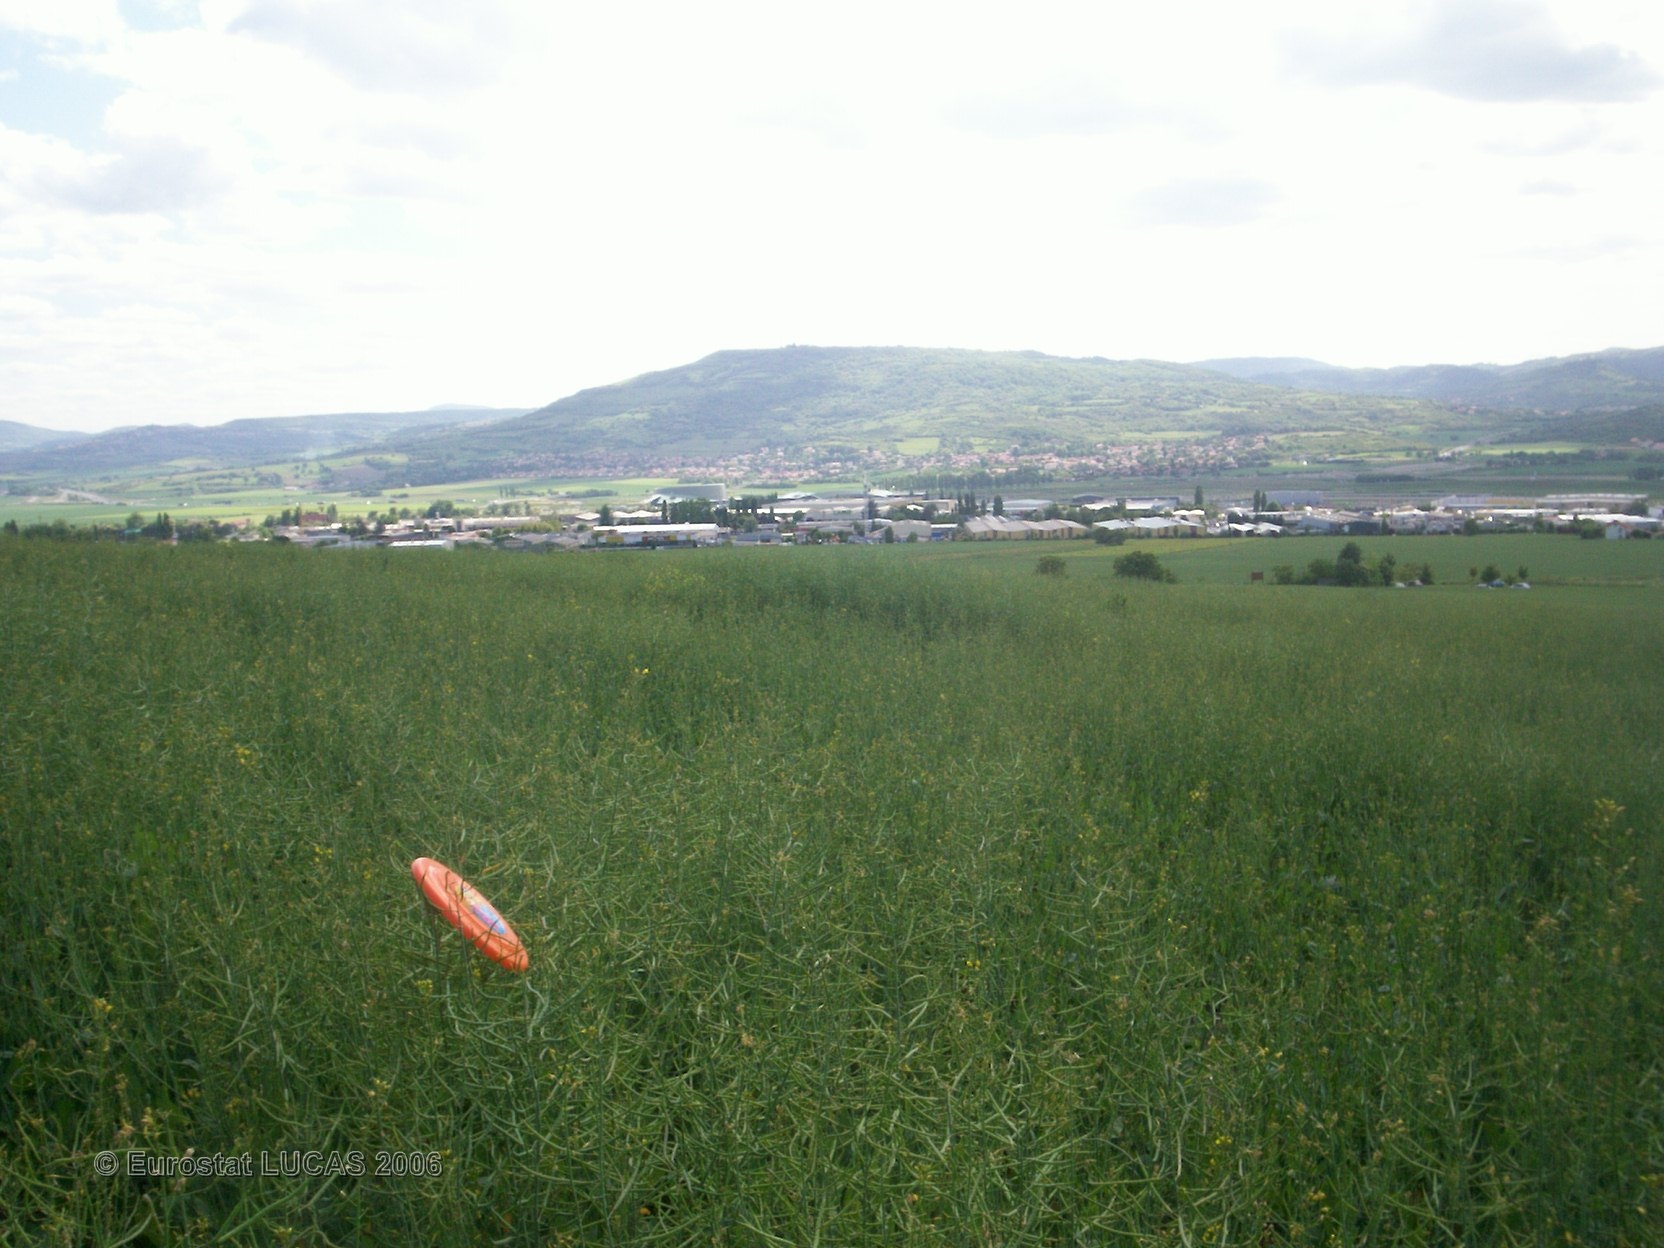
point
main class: Cropland
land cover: Rape and turnip rape
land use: Agriculture (excluding fallow land and kitchen gardens)
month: May
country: FR
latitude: 45.7535
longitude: 3.1738
